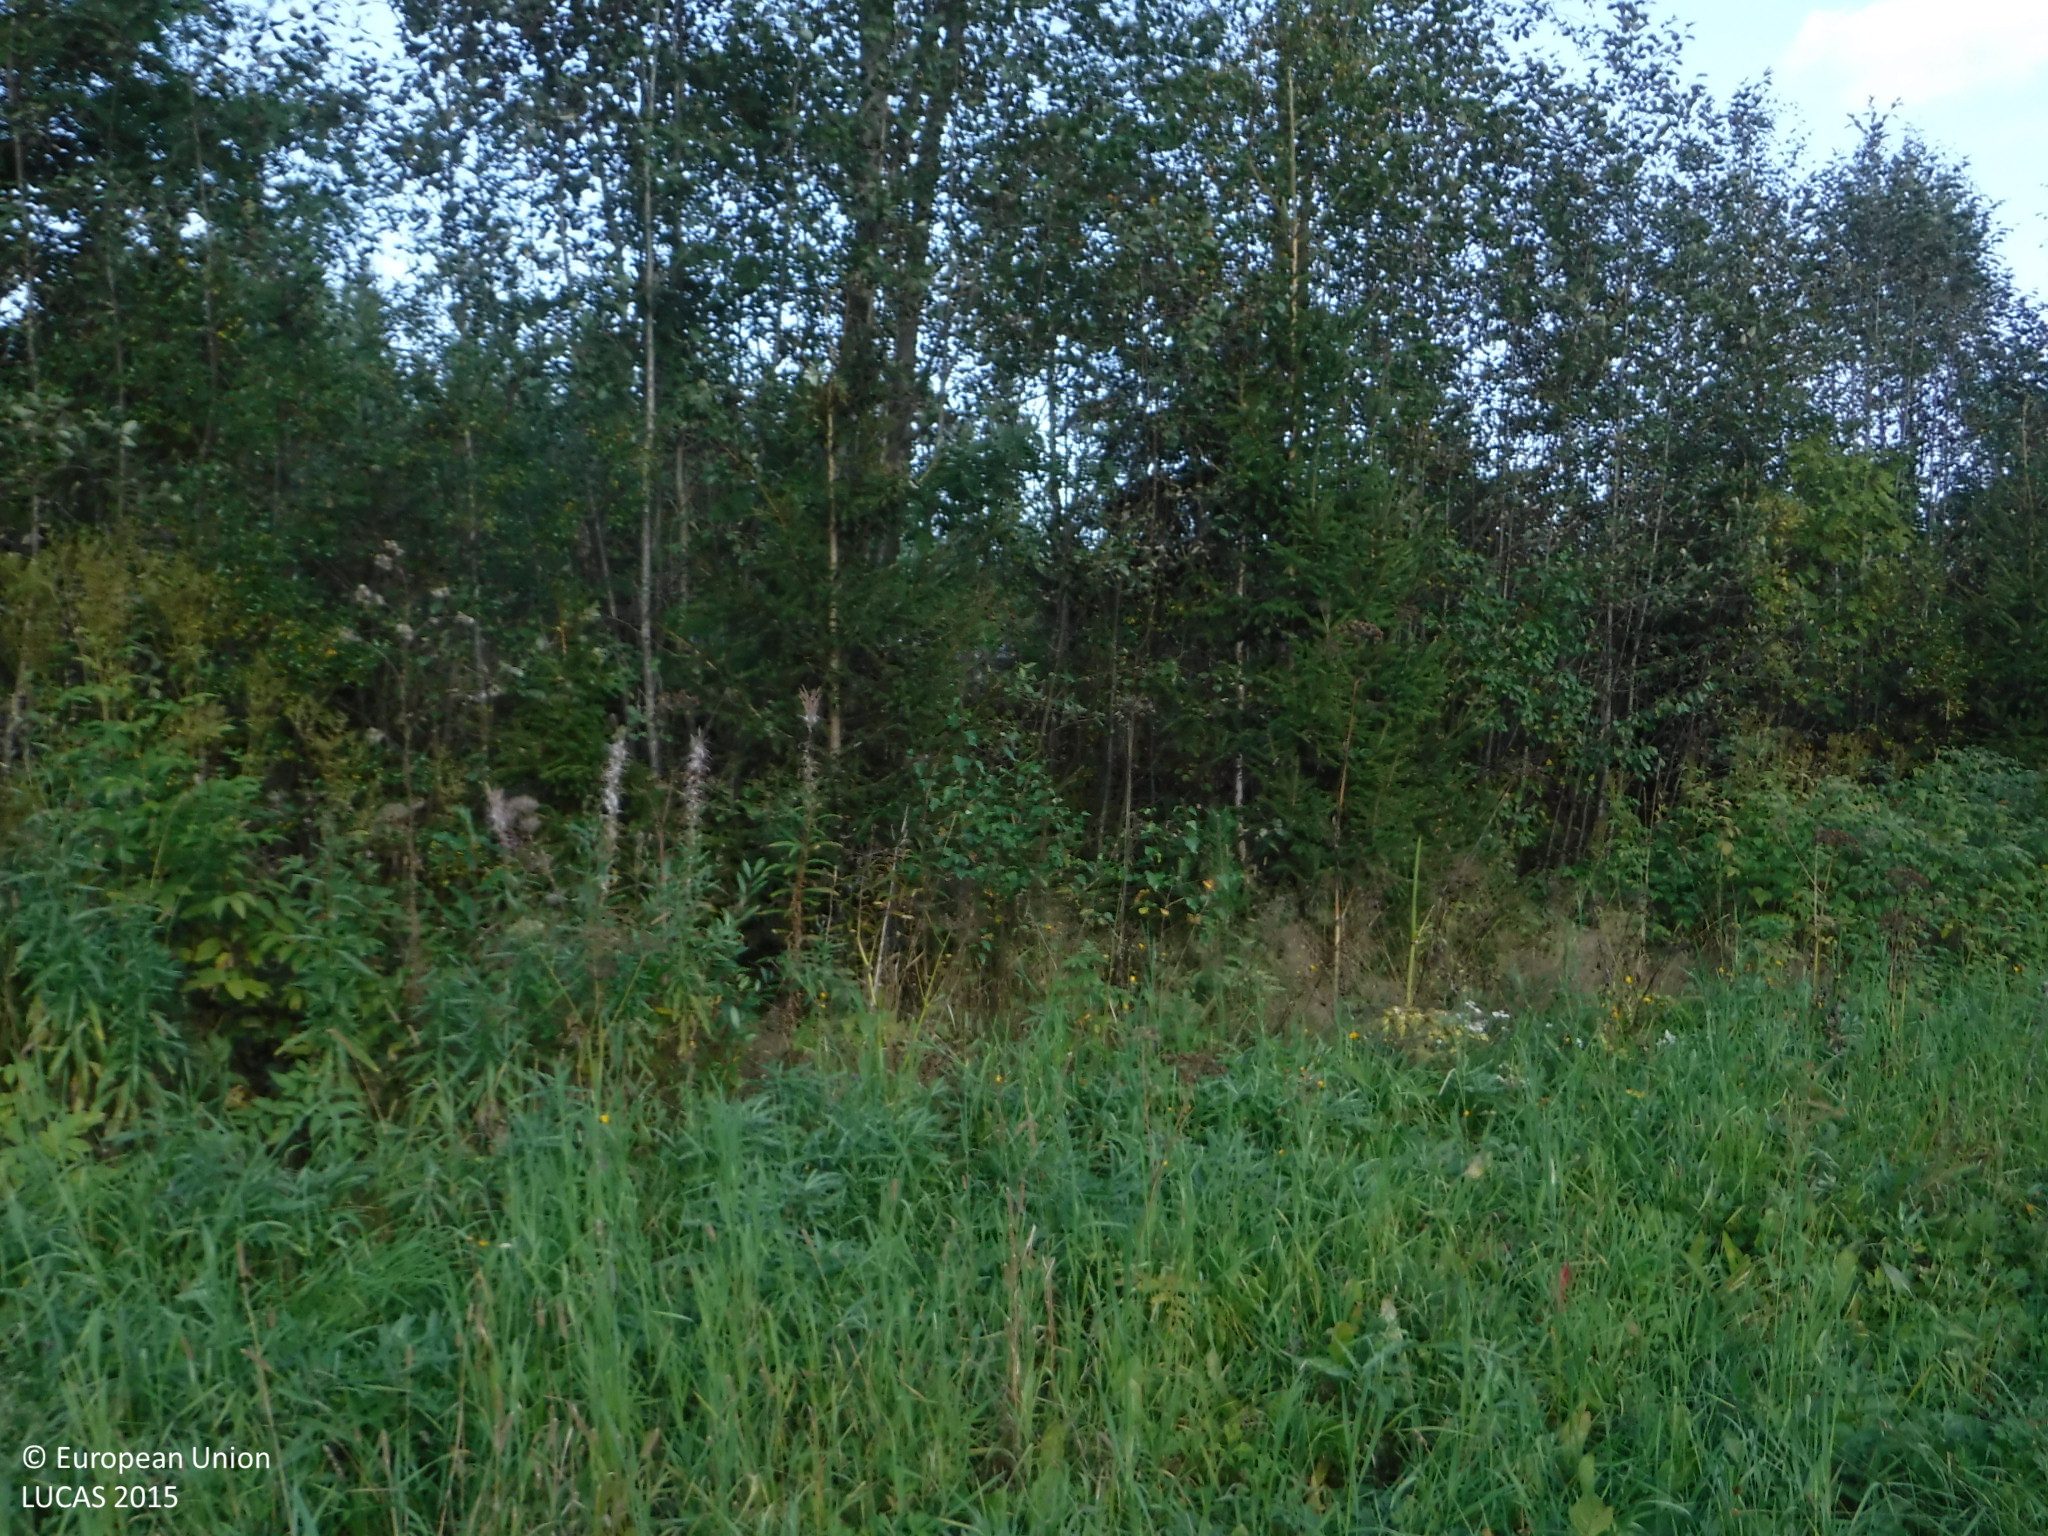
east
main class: Grassland
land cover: Grassland without tree/shrub cover
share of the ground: > 75 %
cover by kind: herbaceous plants 100 %
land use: Agriculture (excluding fallow land and kitchen gardens)
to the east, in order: Grassland without tree/shrub cover; Shruby margins; Ditches and canals; Broadleaved woodland; Spontaneously vegetated surfaces; Ditches and canals; Spontaneously vegetated surfaces; Electric lines; Shrubland without tree cover; Ditches and canals
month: September
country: FI
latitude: 61.7686
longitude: 22.3966
